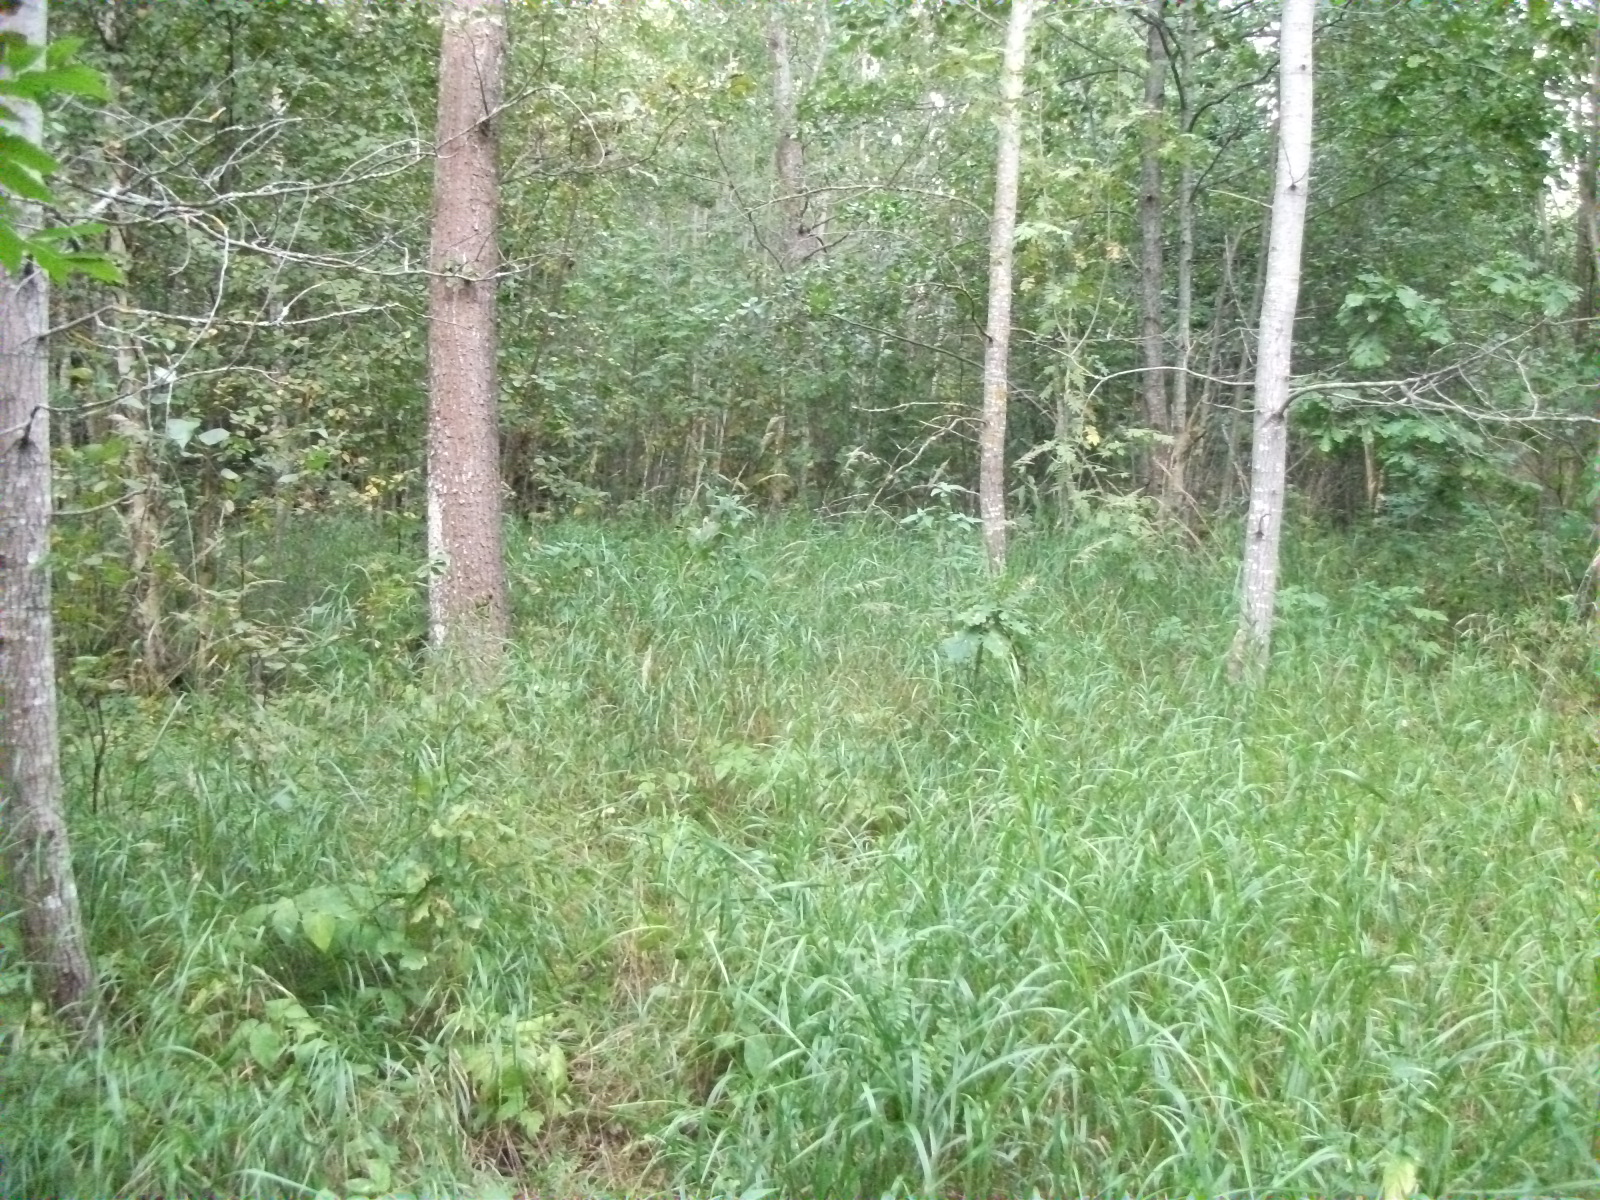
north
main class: Woodland
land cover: Broadleaved woodland
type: non-riverine alder, birch or aspen forest
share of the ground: 50 - 75 %
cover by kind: broadleaved forest trees 60 %, herbaceous plants 35 %, shrubs 5 %
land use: Forestry
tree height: > 5 m
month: August
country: LV
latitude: 56.3089
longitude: 26.3238
